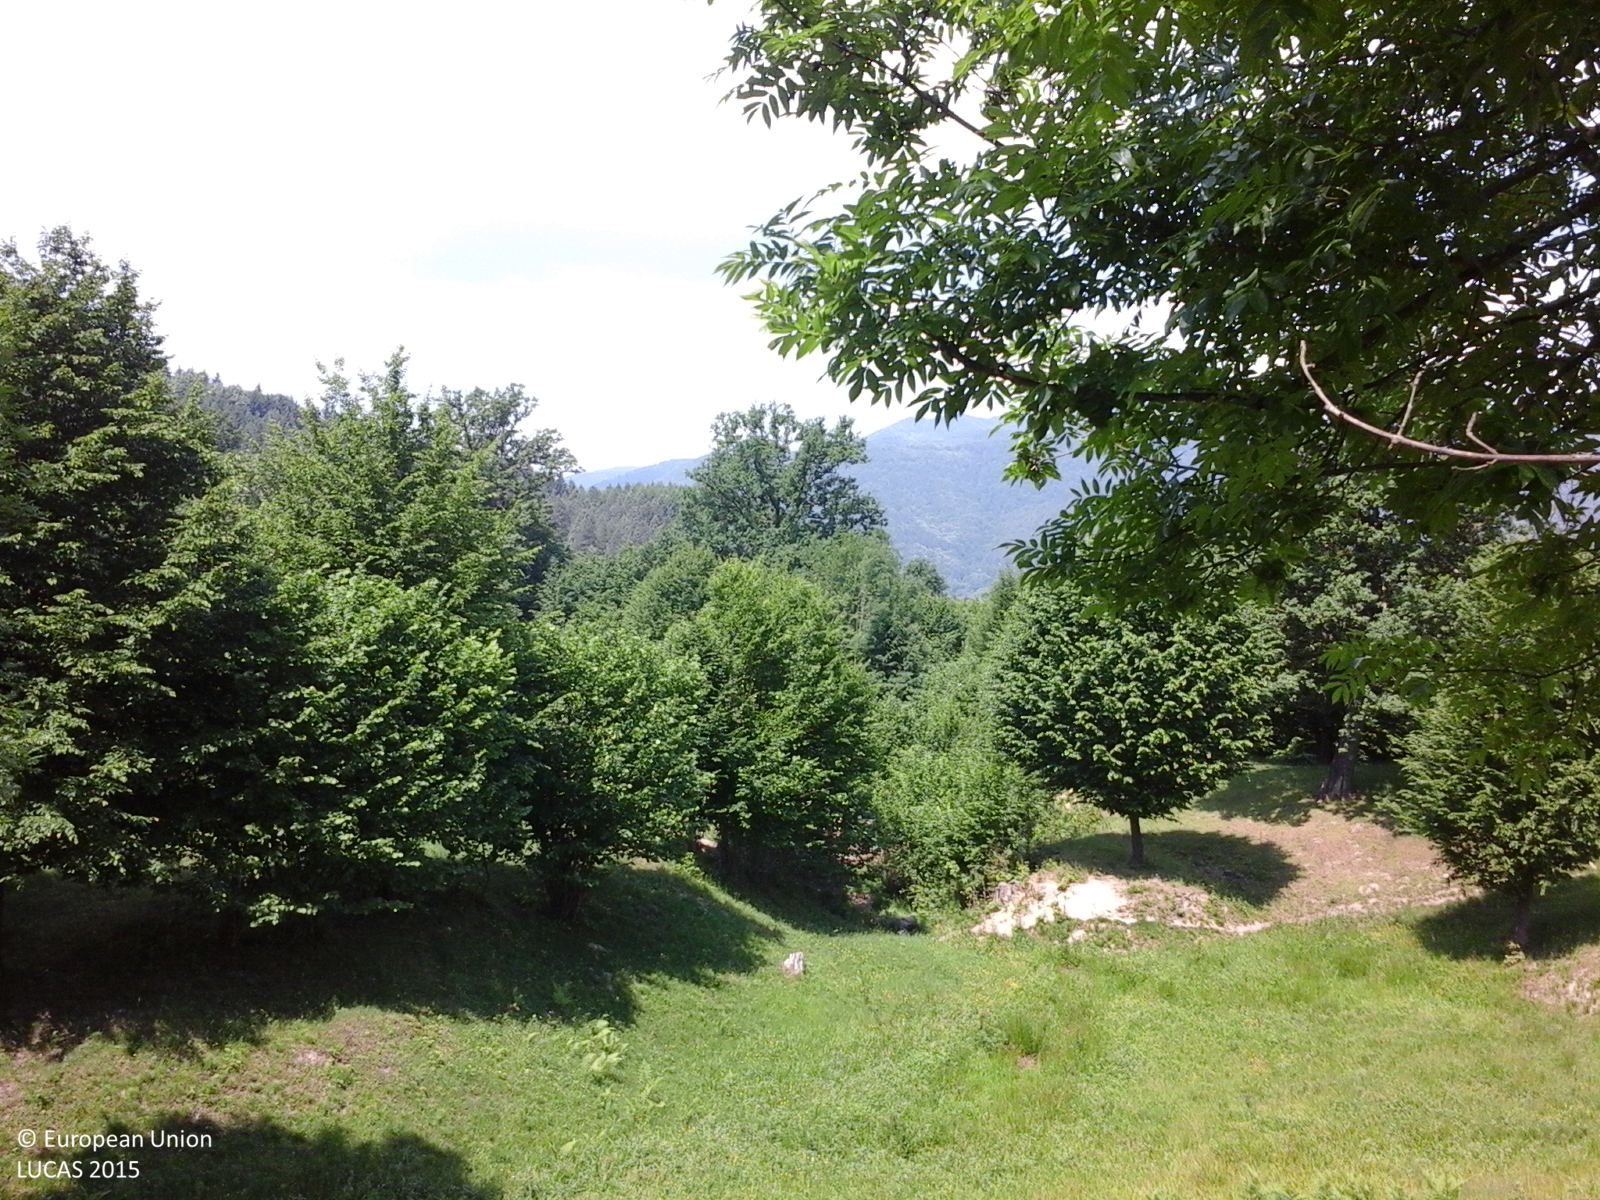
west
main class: Grassland
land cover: Grassland with sparse tree/shrub cover
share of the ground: > 75 %
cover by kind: herbaceous plants 95 %, broadleaved forest trees 5 %
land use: Agriculture (excluding fallow land and kitchen gardens)
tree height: > 5 m
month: June
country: RO
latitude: 46.3360
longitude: 26.4351
